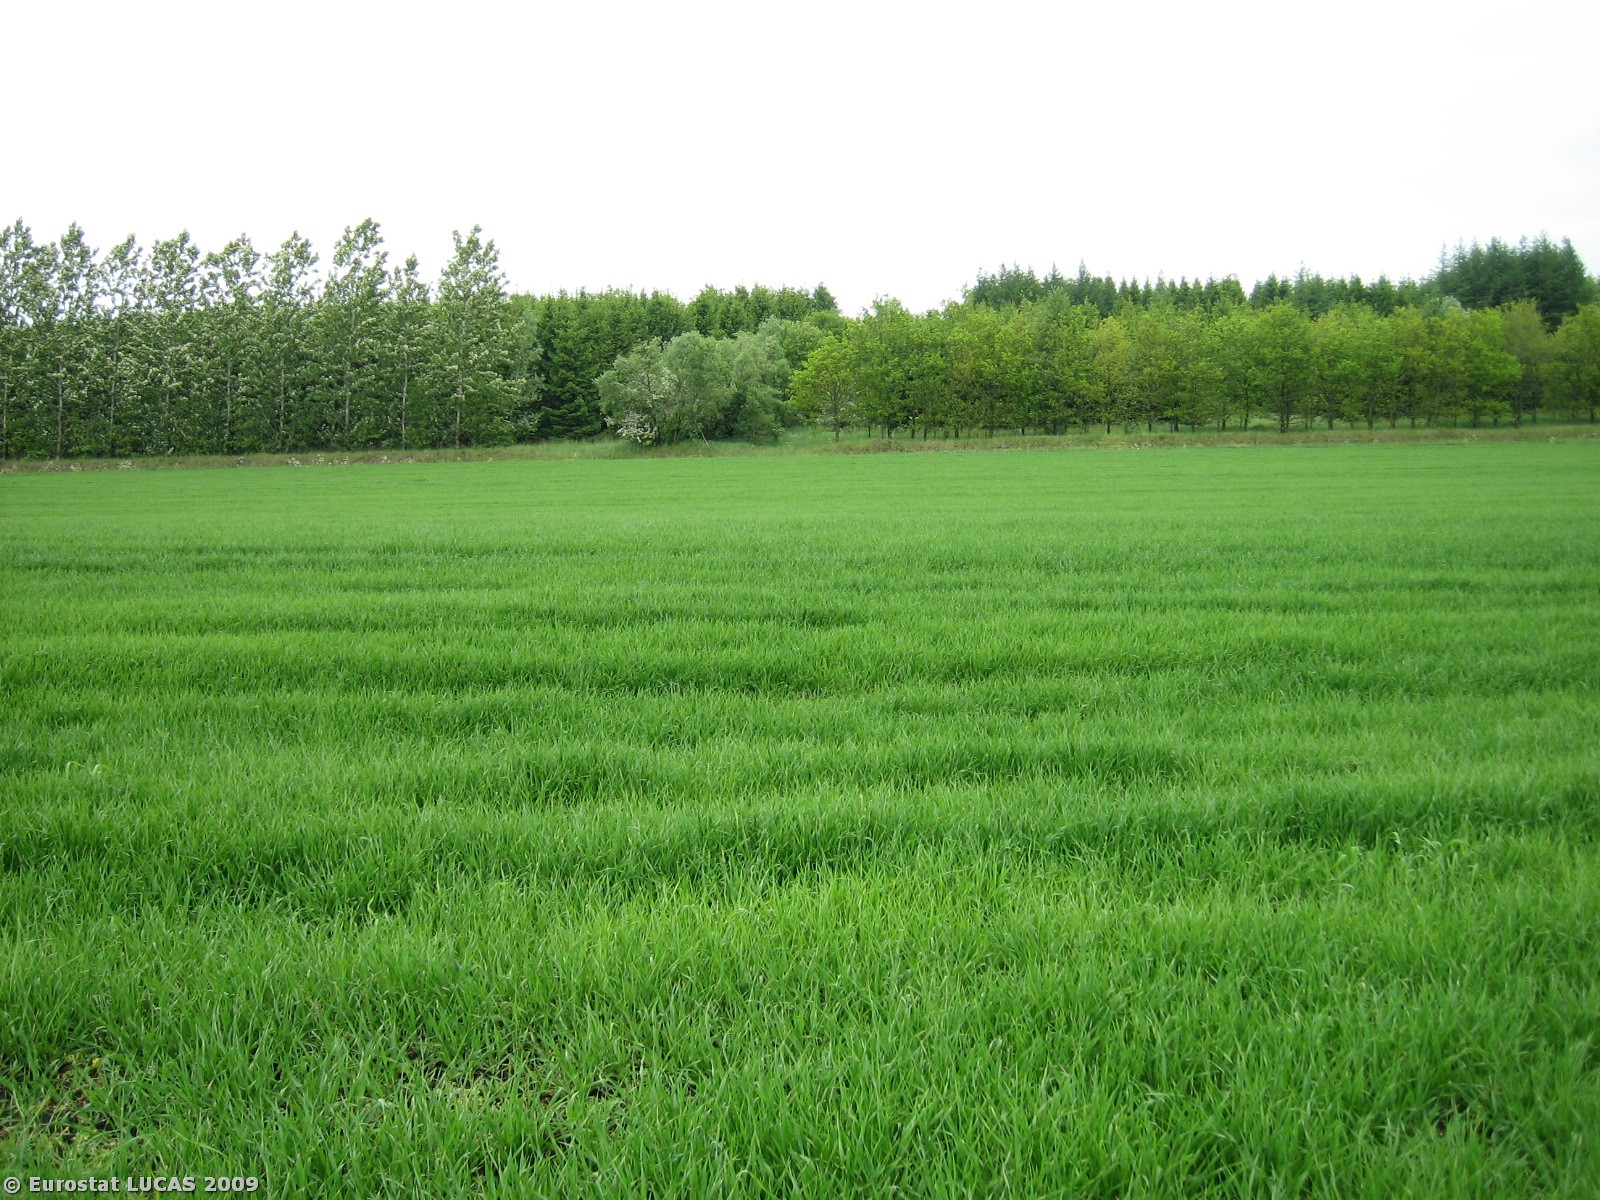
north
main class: Grassland
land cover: Grassland without tree/shrub cover
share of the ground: > 75 %
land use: Unused
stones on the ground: < 10 %
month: May
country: DK
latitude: 55.8616
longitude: 9.1860
